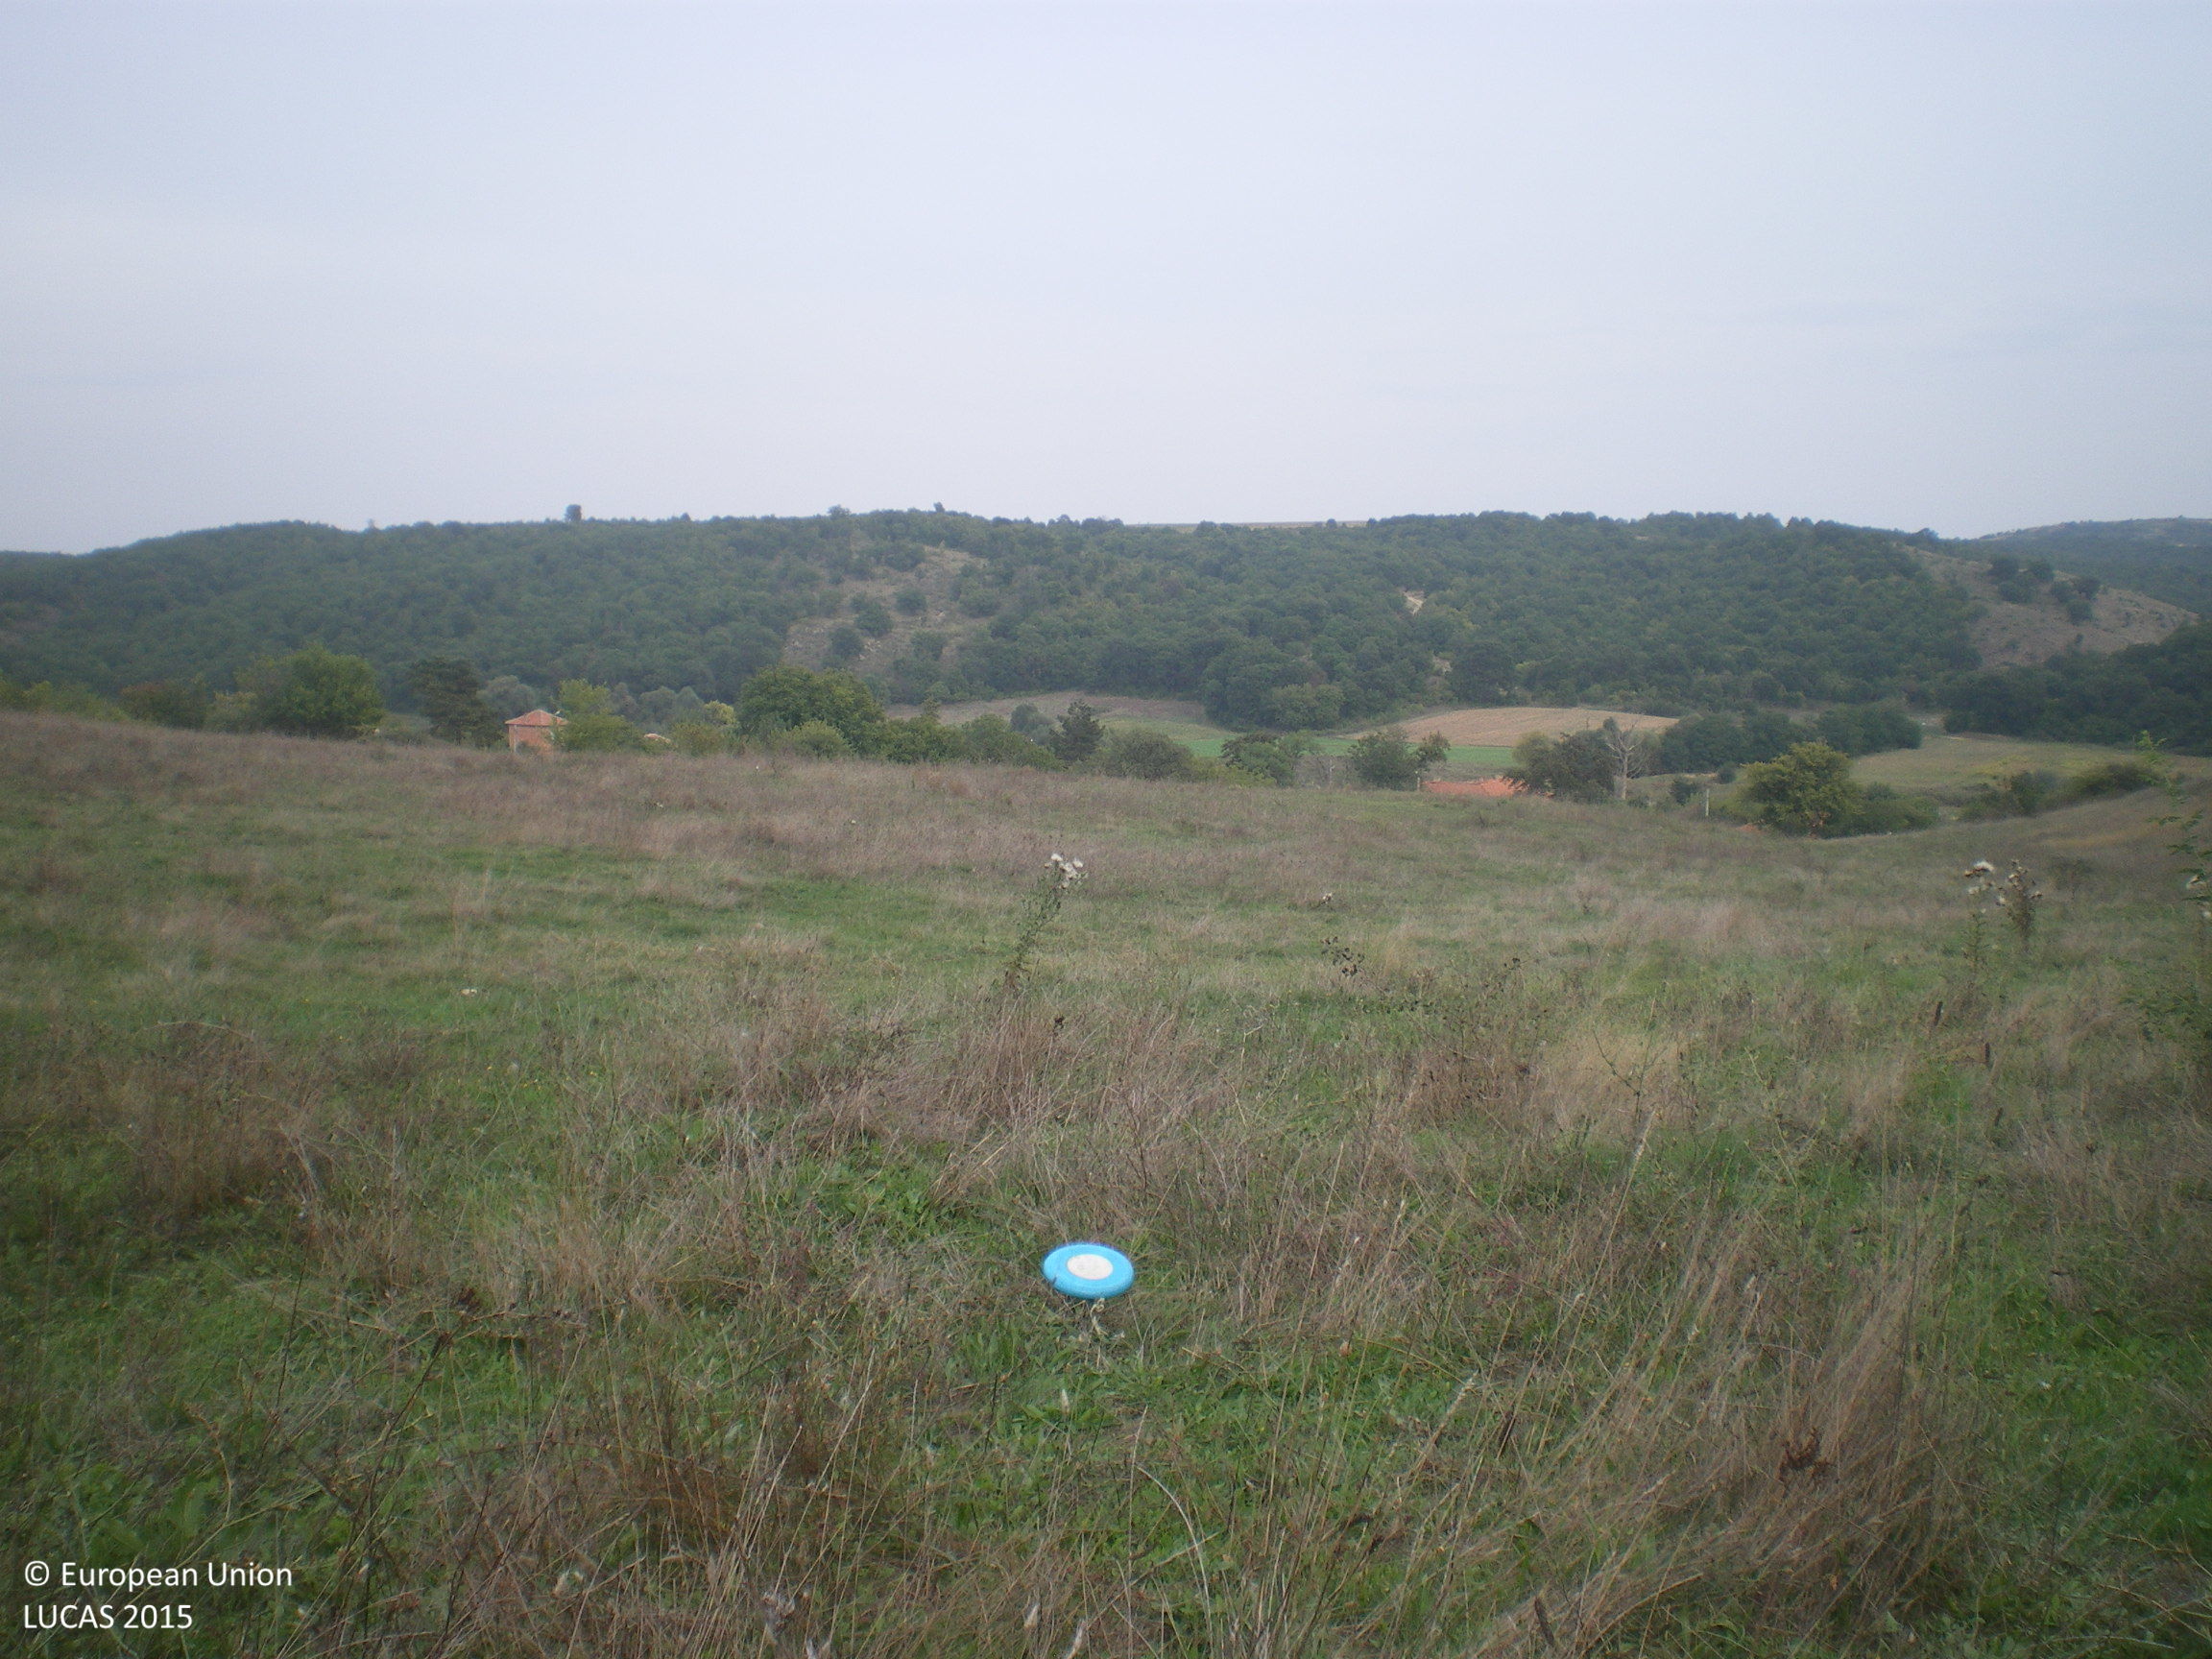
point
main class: Grassland
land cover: Grassland without tree/shrub cover
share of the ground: > 75 %
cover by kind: herbaceous plants 100 %
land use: Agriculture (excluding fallow land and kitchen gardens)
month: September
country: BG
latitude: 41.8467
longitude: 25.9082
